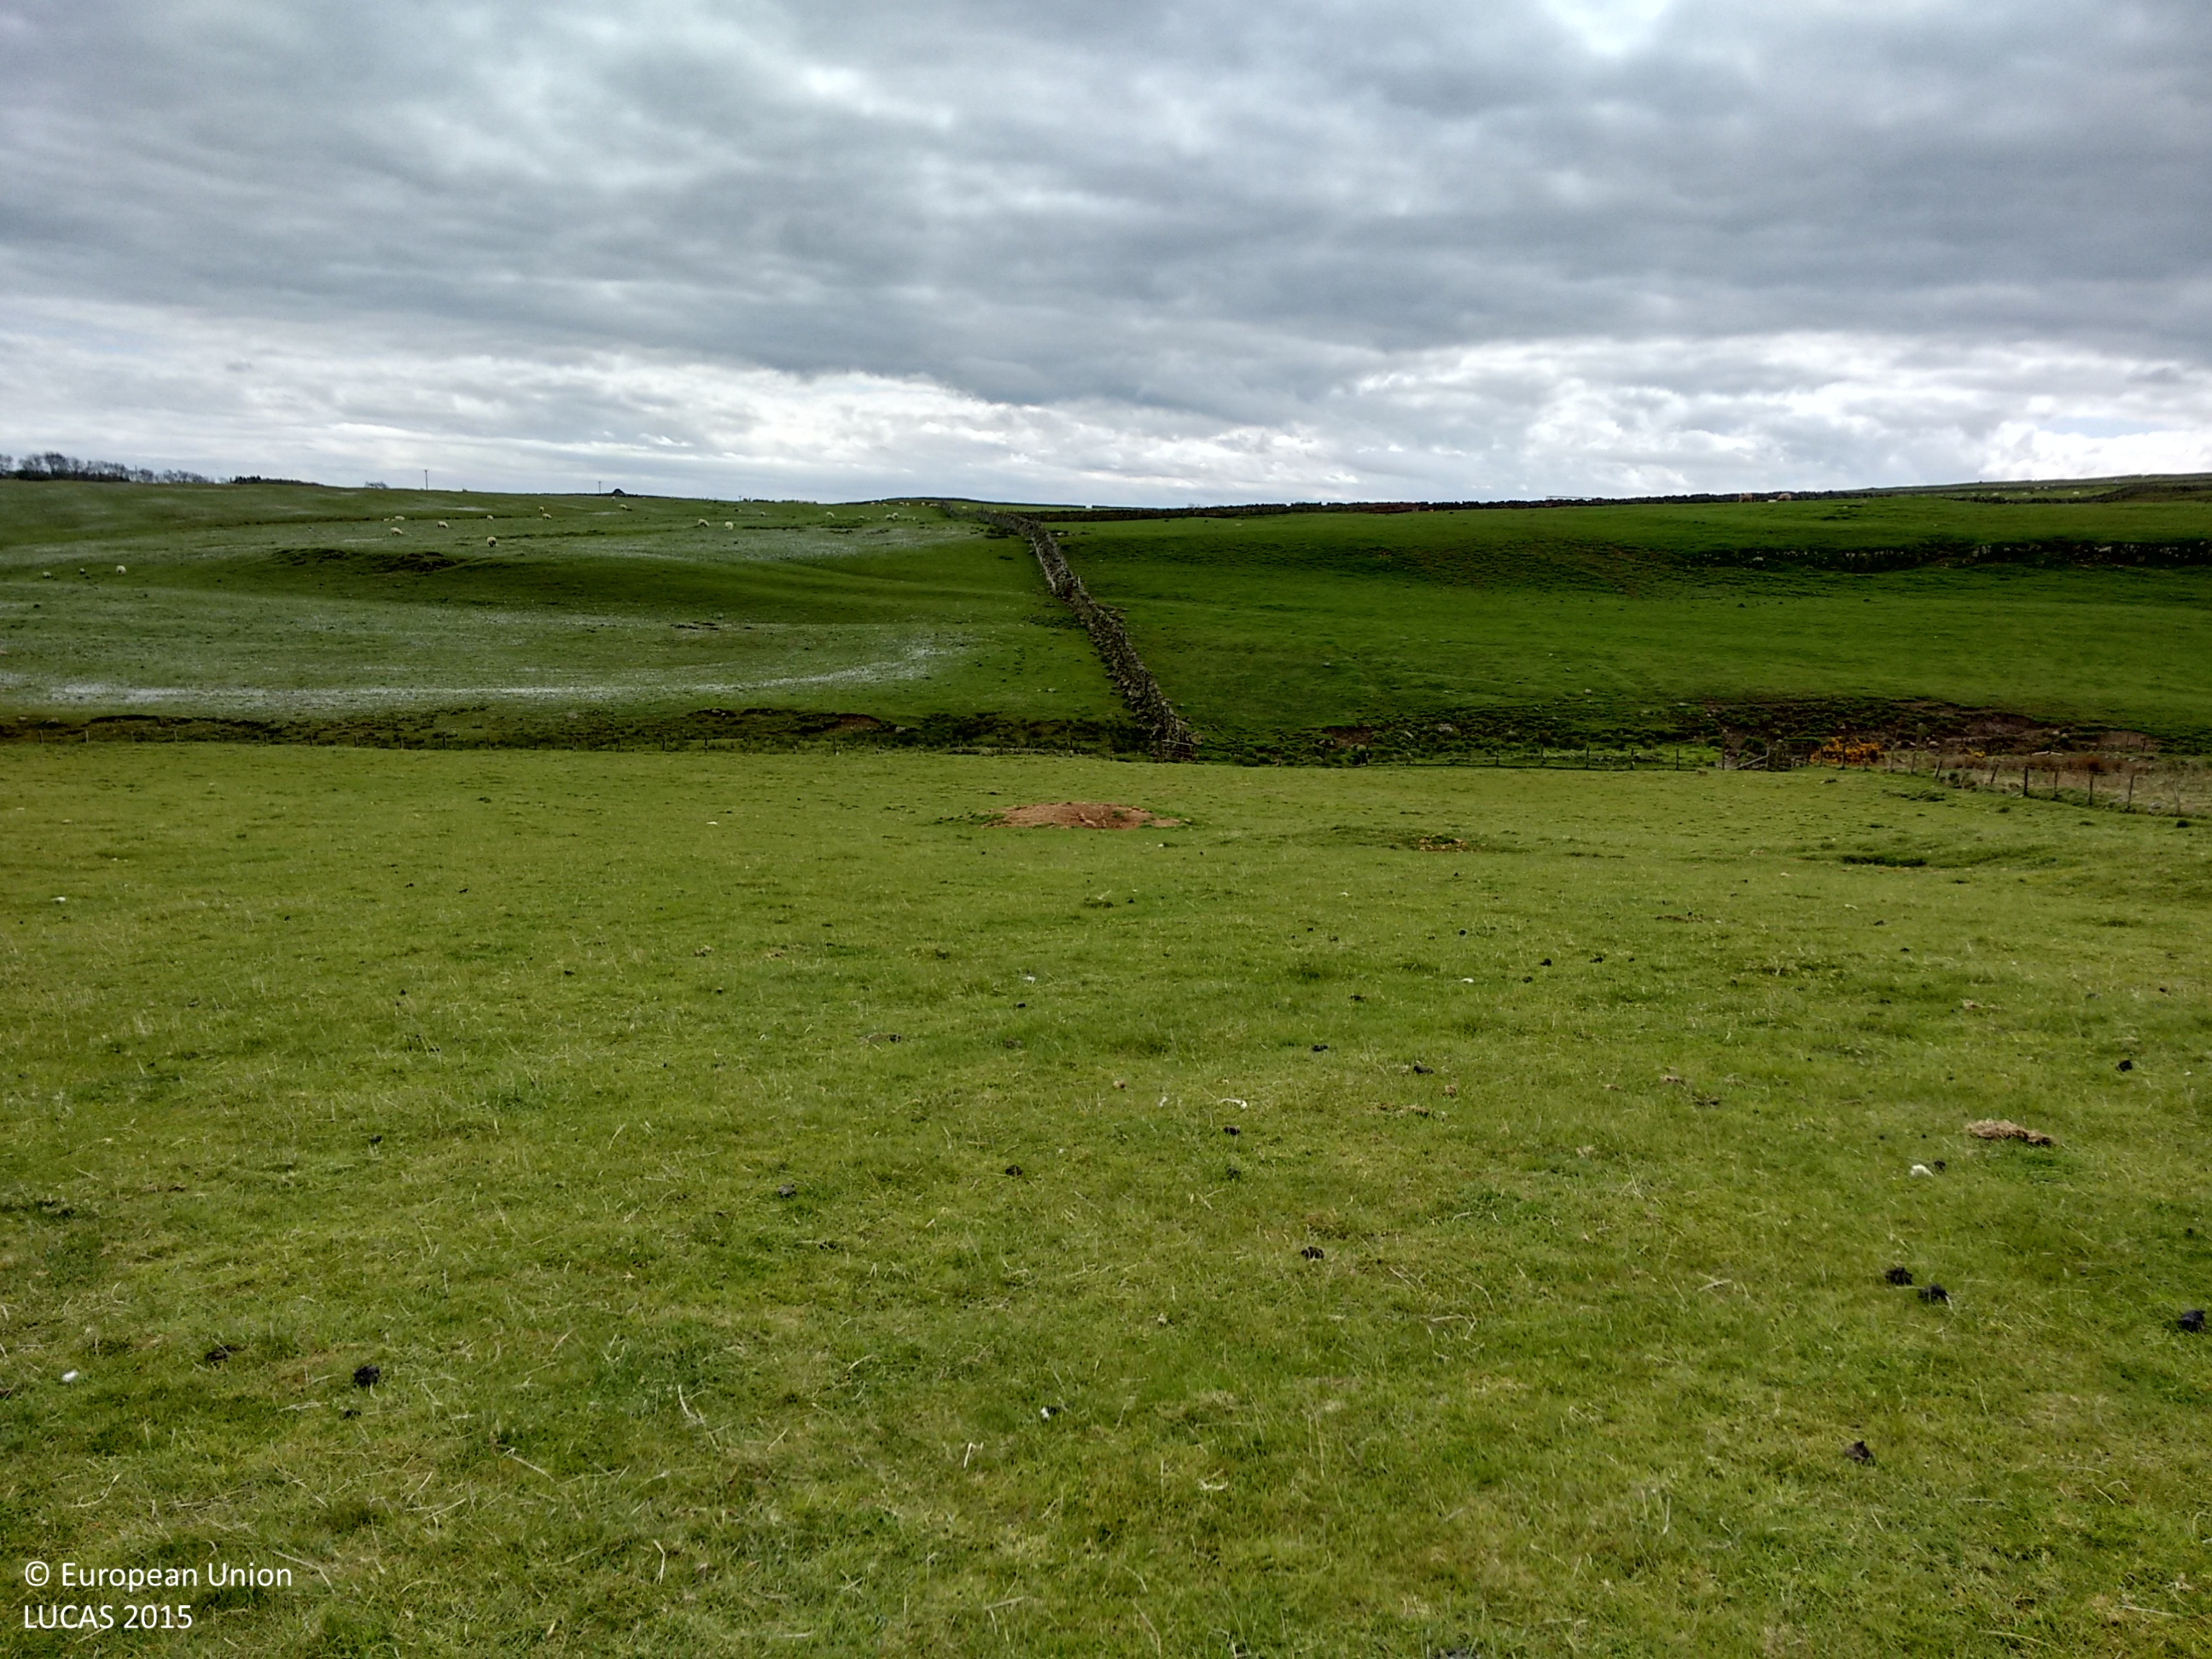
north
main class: Grassland
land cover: Grassland without tree/shrub cover
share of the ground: > 75 %
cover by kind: herbaceous plants 100 %
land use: Agriculture (excluding fallow land and kitchen gardens)
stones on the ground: < 10 %
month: May
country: GB
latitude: 55.1289
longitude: -2.0209
